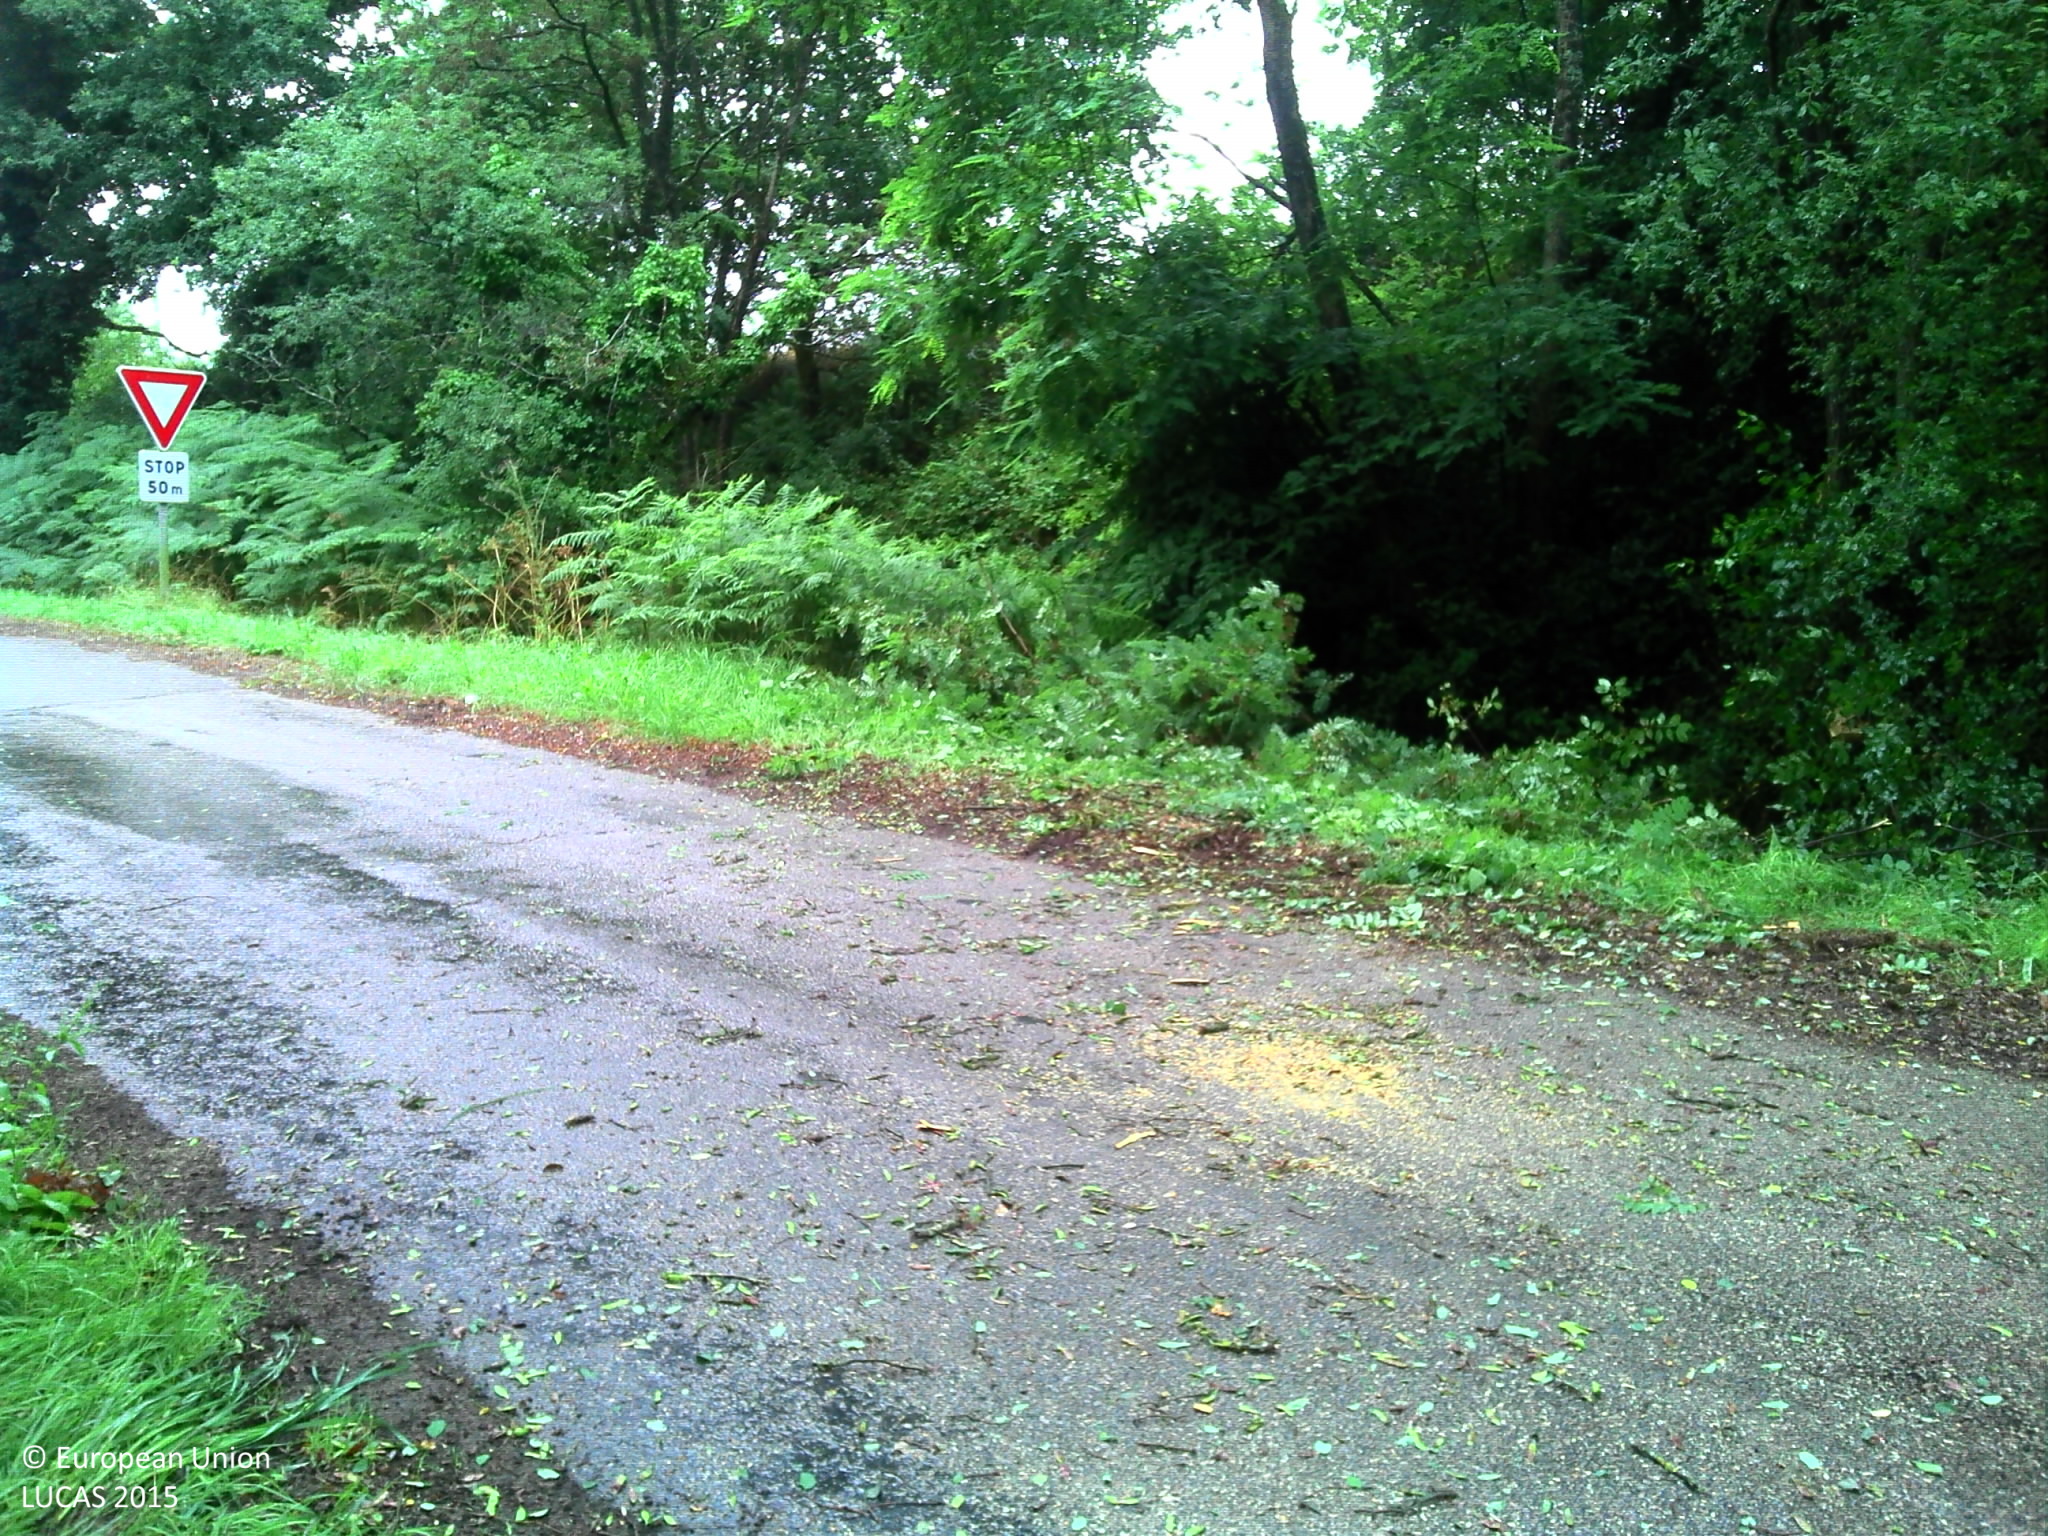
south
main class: Woodland
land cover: Broadleaved woodland
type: acidophilous oak and oak-birch forest
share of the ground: > 75 %
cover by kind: broadleaved forest trees 60 %, shrubs 15 %, herbaceous plants 15 %, consolidated bare surface 10 %
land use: Forestry
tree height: > 5 m
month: July
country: FR
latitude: 47.7477
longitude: -3.0992
